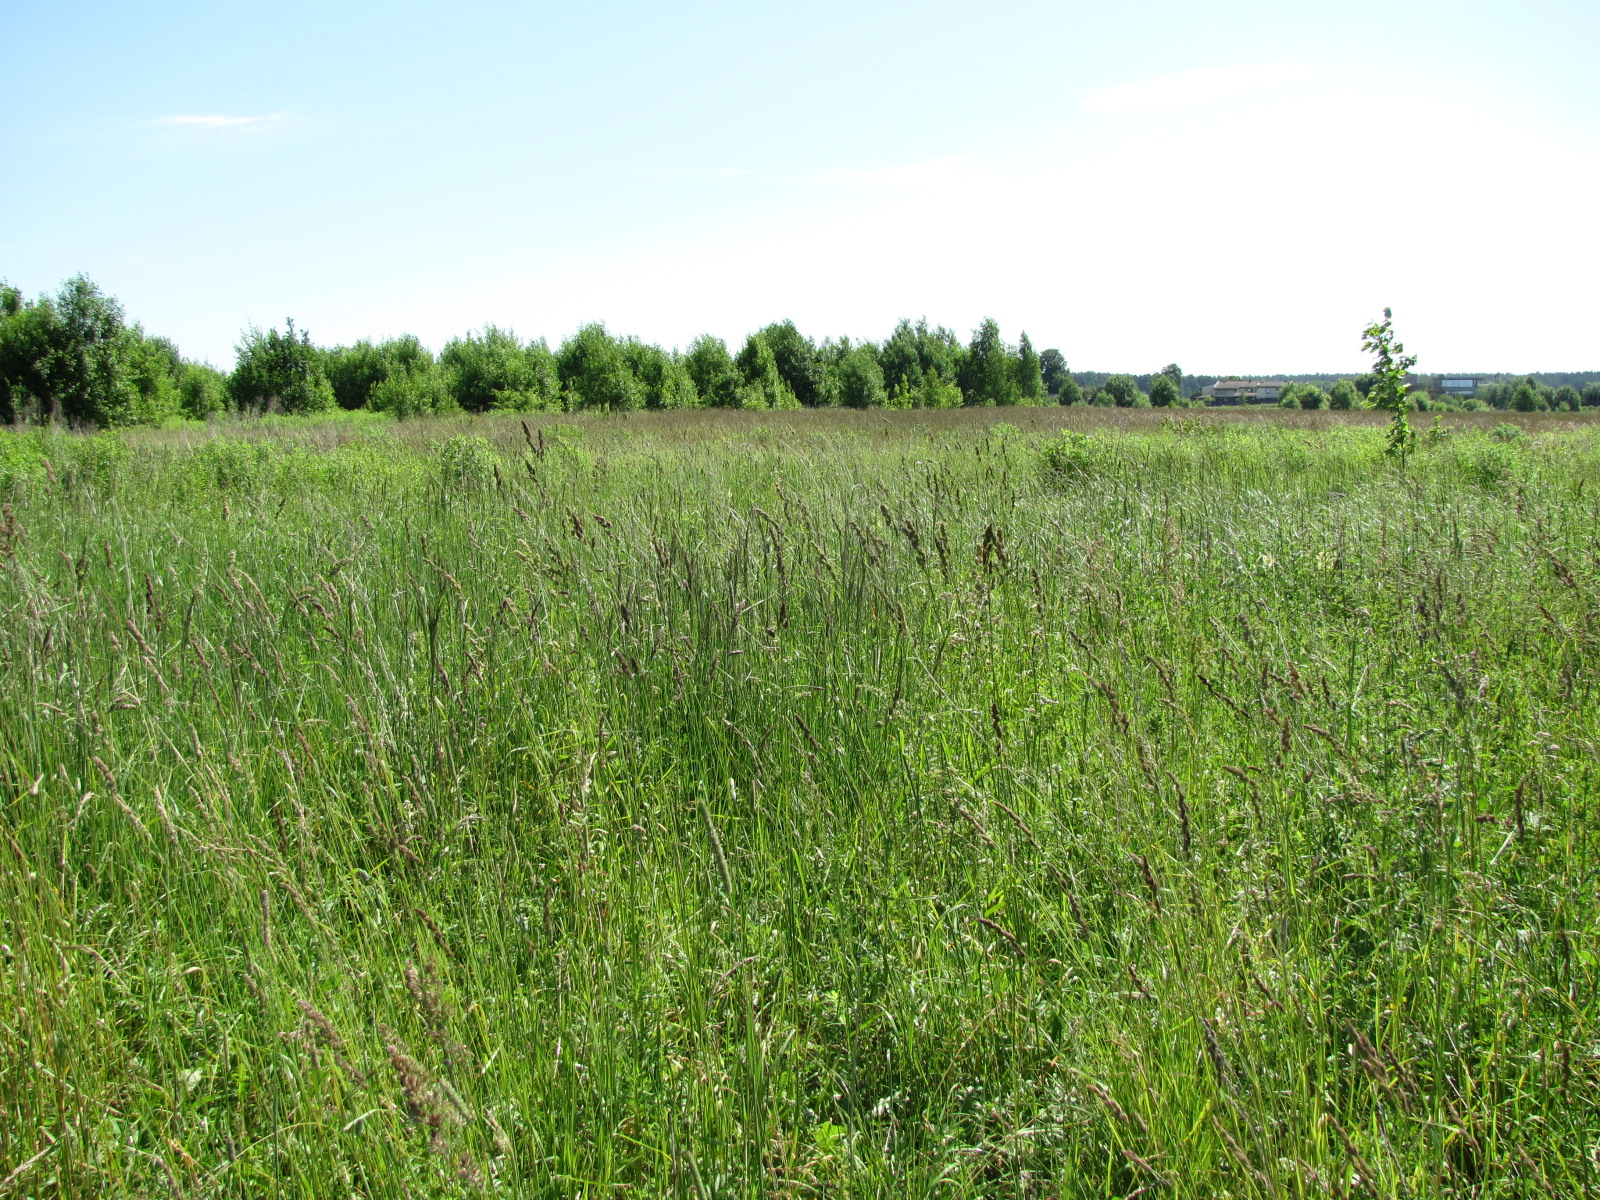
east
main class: Grassland
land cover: Grassland with sparse tree/shrub cover
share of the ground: > 75 %
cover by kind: herbaceous plants 95 %, broadleaved forest trees 5 %
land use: Abandoned areas
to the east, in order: Grassland with sparse tree/shrub cover; Grassland without tree/shrub cover; Broadleaved woodland; Grassland with sparse tree/shrub cover; Broadleaved woodland; Grassland without tree/shrub cover; Spontaneously vegetated surfaces; Grassland with sparse tree/shrub cover
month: July
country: LV
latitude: 56.8763
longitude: 24.1820
